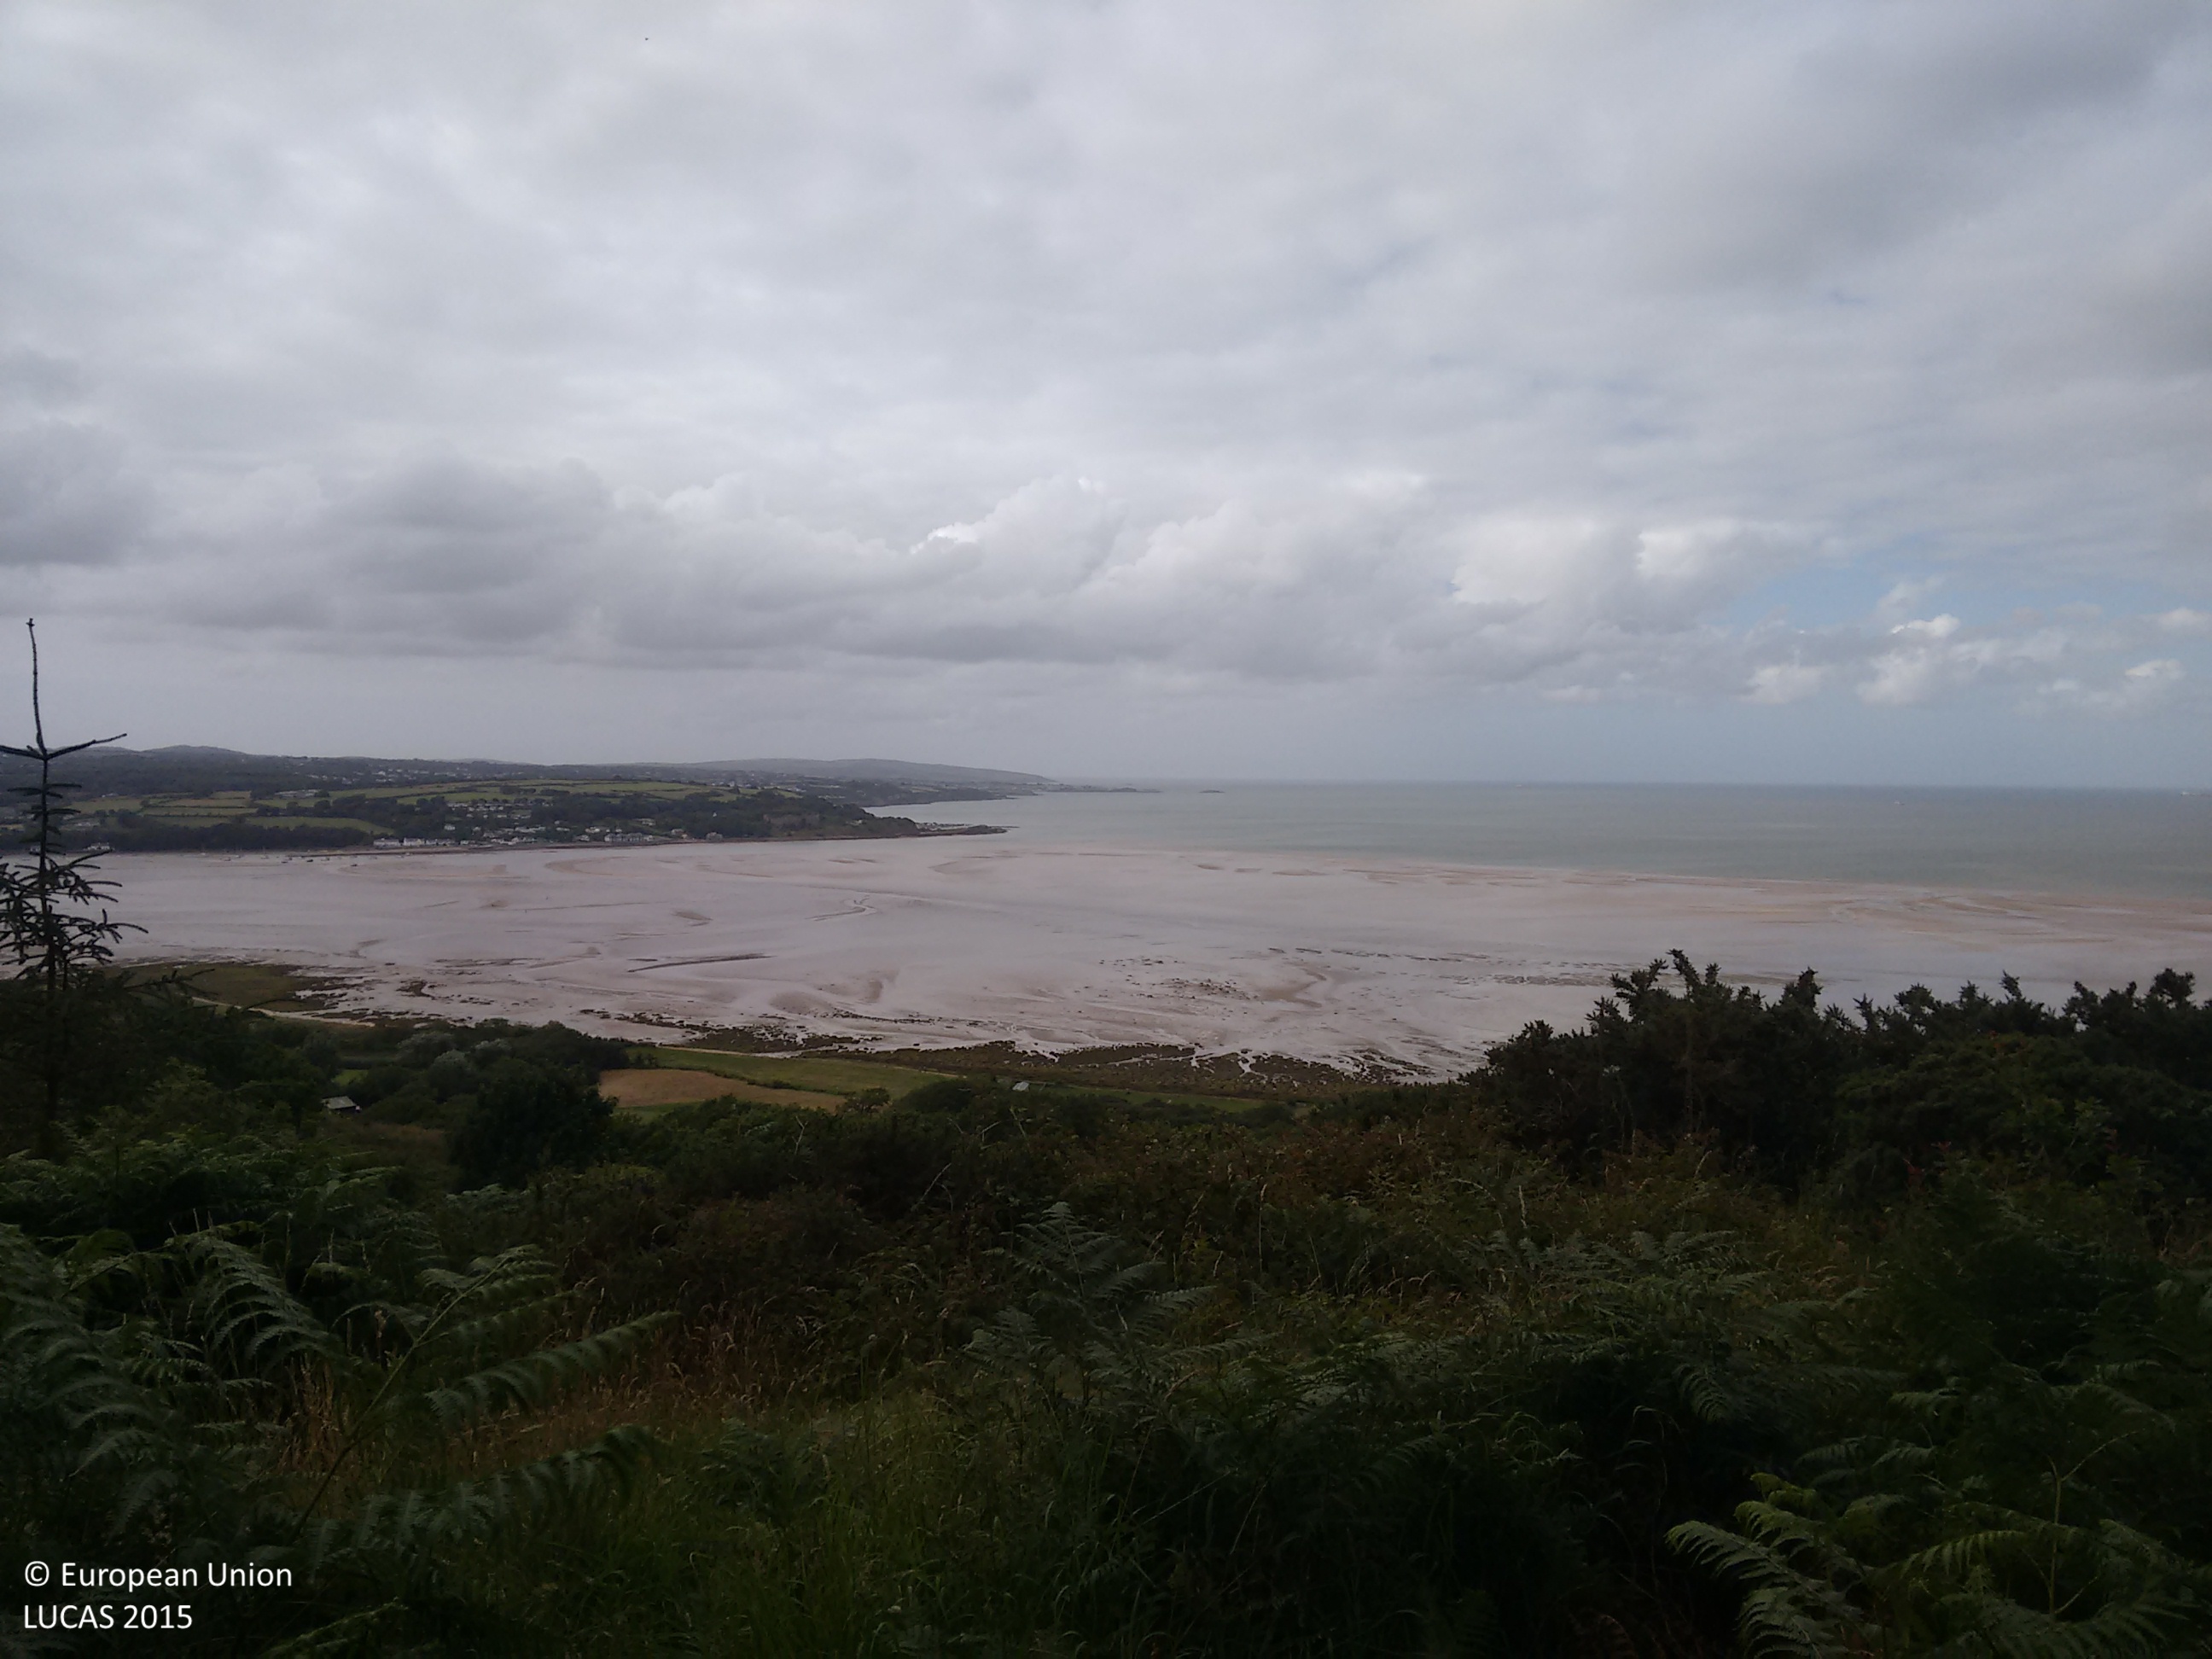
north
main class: Woodland
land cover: Other coniferous woodland
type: exotic forest
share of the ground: > 75 %
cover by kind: coniferous forest trees 100 %
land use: Forestry
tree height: > 5 m
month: August
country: GB
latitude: 53.2919
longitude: -4.1849
